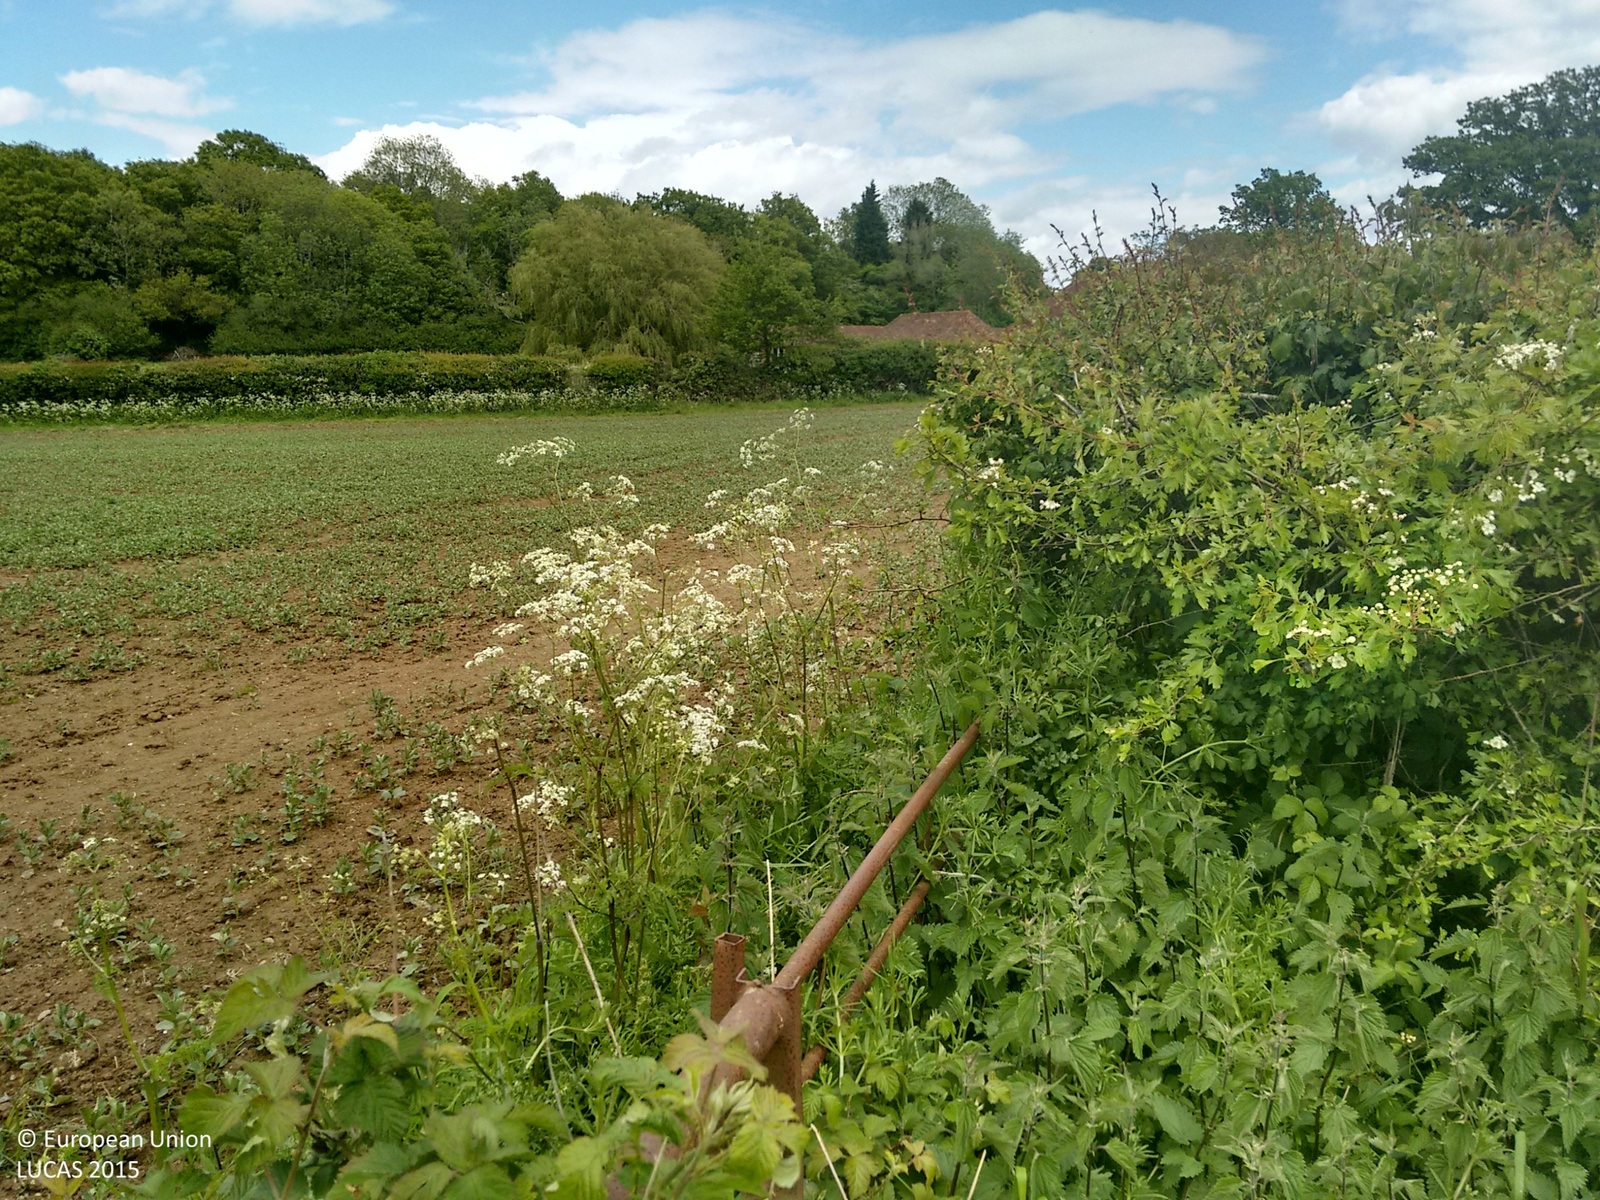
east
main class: Cropland
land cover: Dry pulses
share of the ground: 50 - 75 %
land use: Agriculture (excluding fallow land and kitchen gardens)
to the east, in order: Dry pulses; Managed hedges; Grassland without tree/shrub cover; Inland fresh water bodies; Grassland with sparse tree/shrub cover; Artificial constructions in urban areas; Grassland without tree/shrub cover; Inland fresh water bodies; Broadleaved woodland; Inland fresh water bodies; Grassland with sparse tree/shrub cover; Artificial constructions in urban areas; Grassland without tree/shrub cover; Managed hedges; Grassland without tree/shrub cover
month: May
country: GB
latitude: 51.1514
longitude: 0.1470
